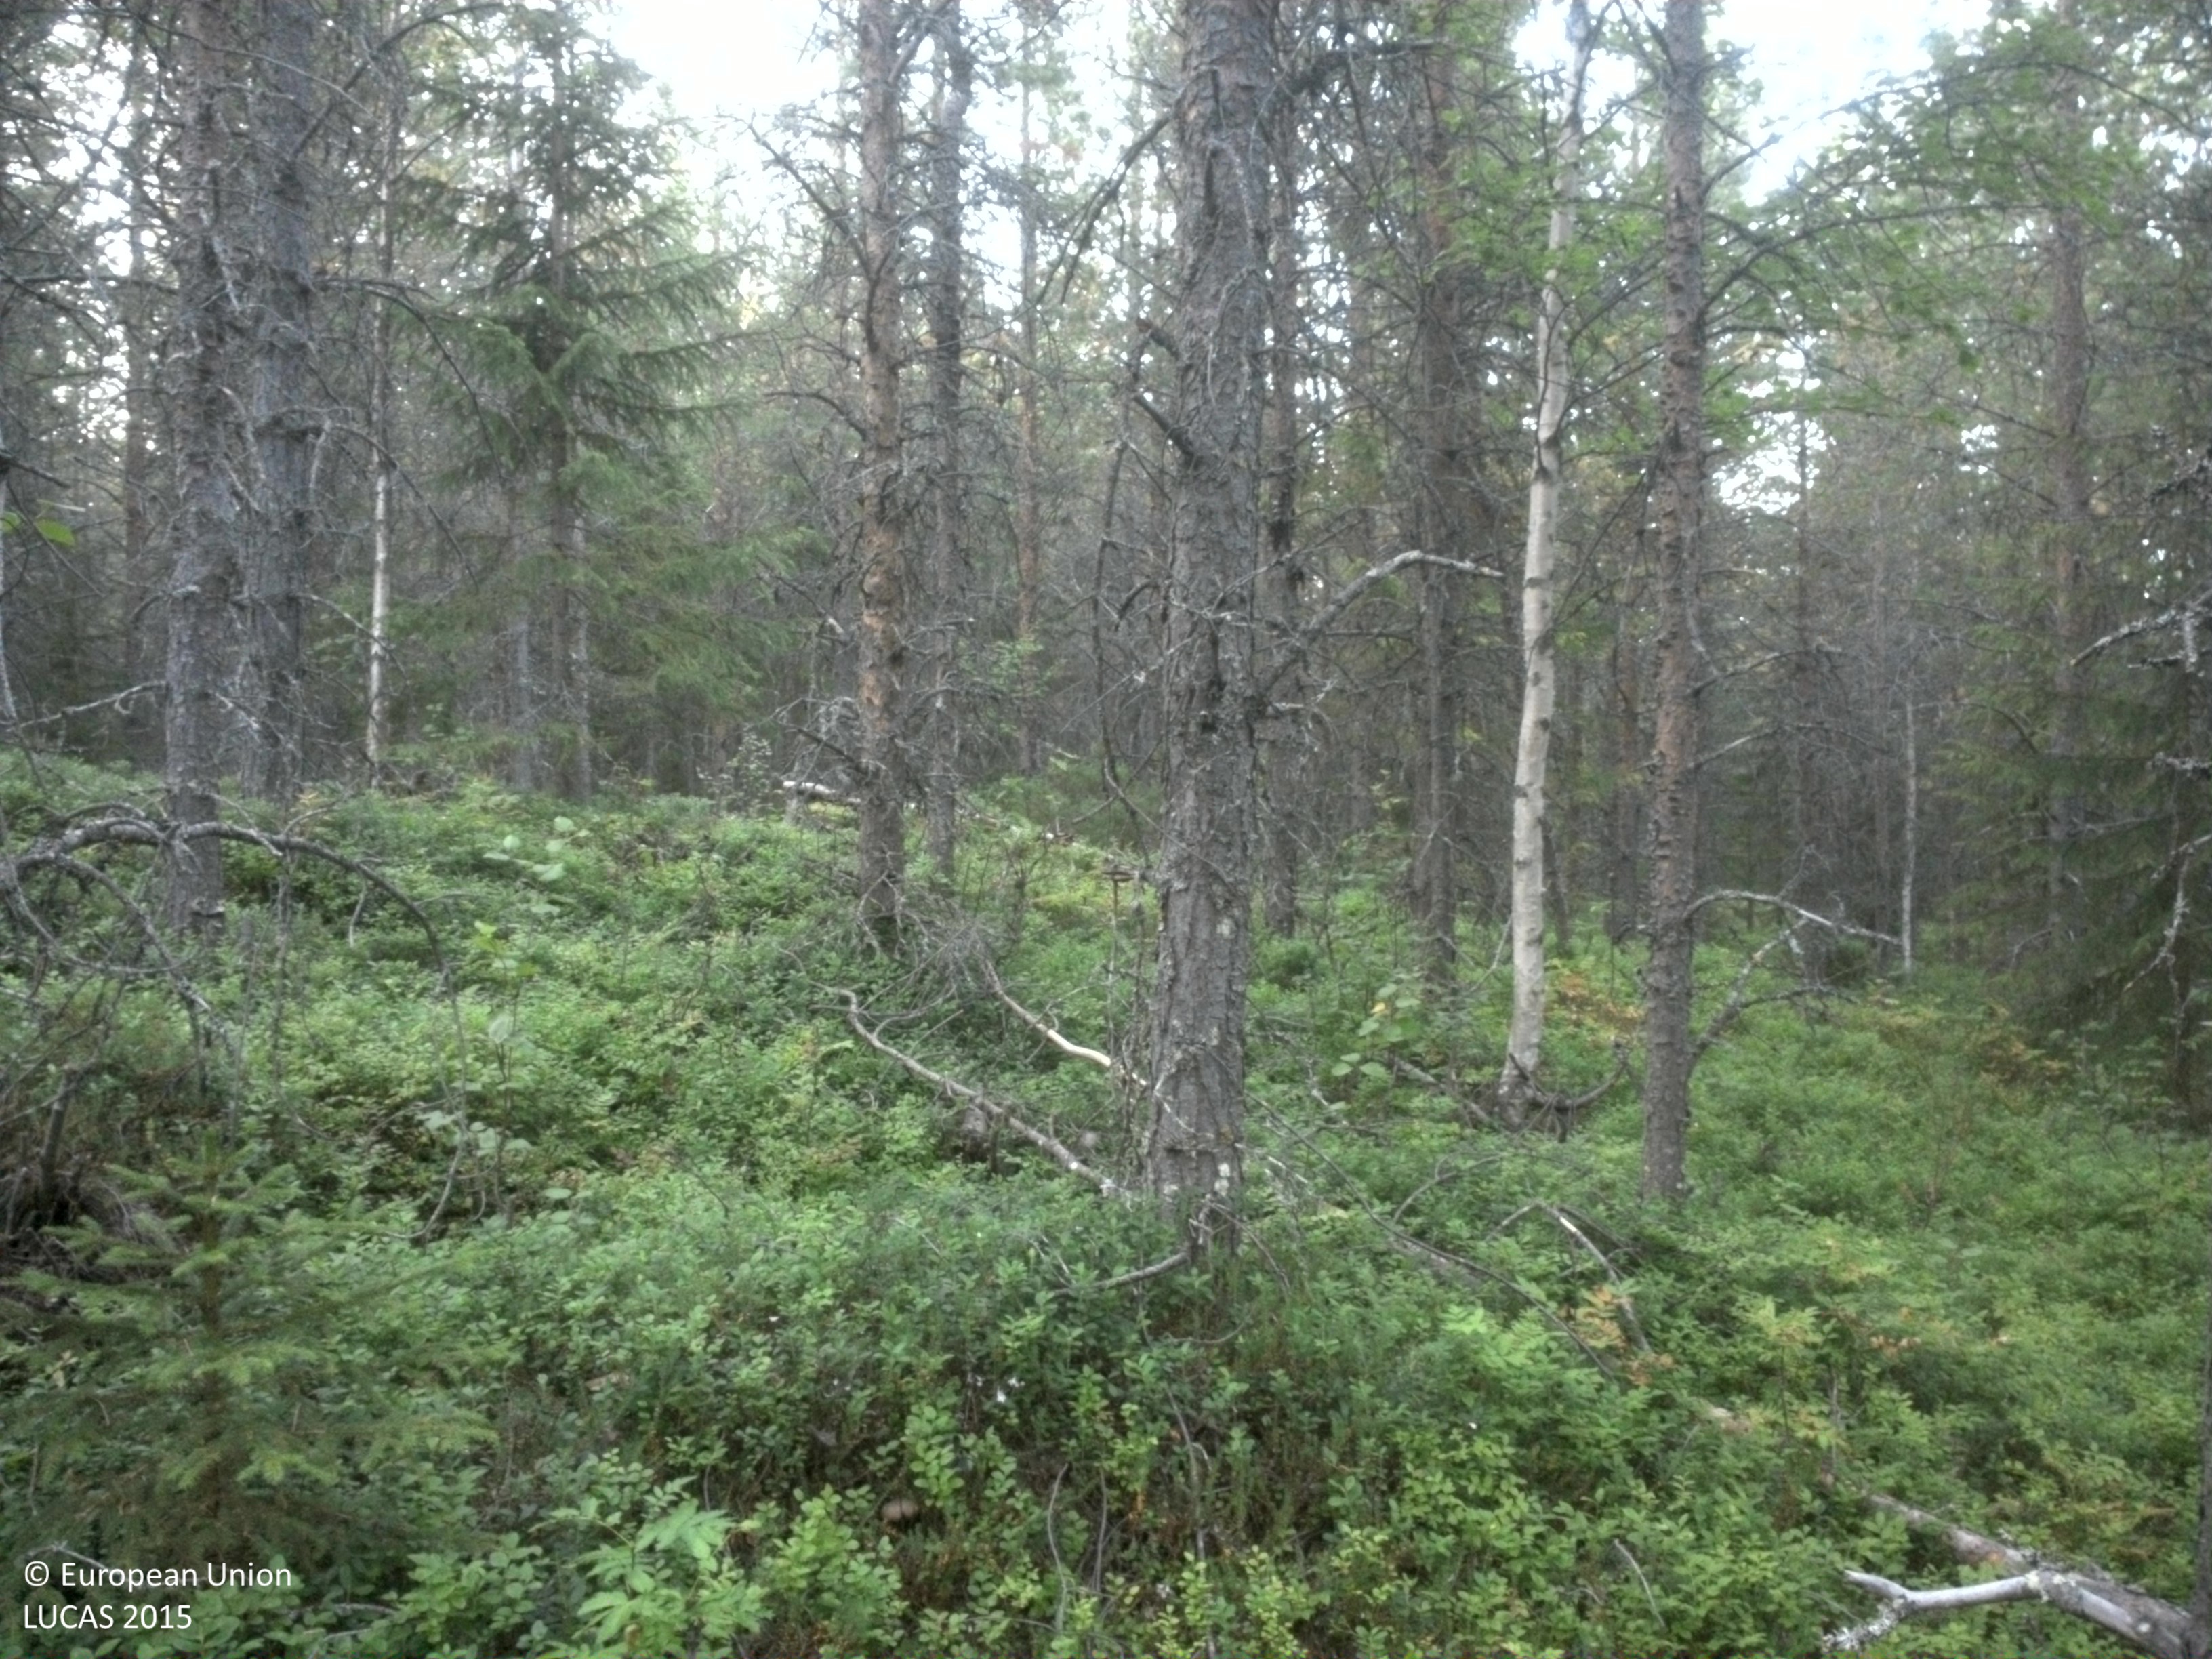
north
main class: Woodland
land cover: Pine dominated coniferous woodland
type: boreal forest
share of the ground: 50 - 75 %
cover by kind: coniferous forest trees 60 %, shrubs 30 %, broadleaved forest trees 5 %, lichens and mosses 5 %
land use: Forestry
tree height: > 5 m
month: August
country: SE
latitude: 64.6122
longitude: 18.3916
